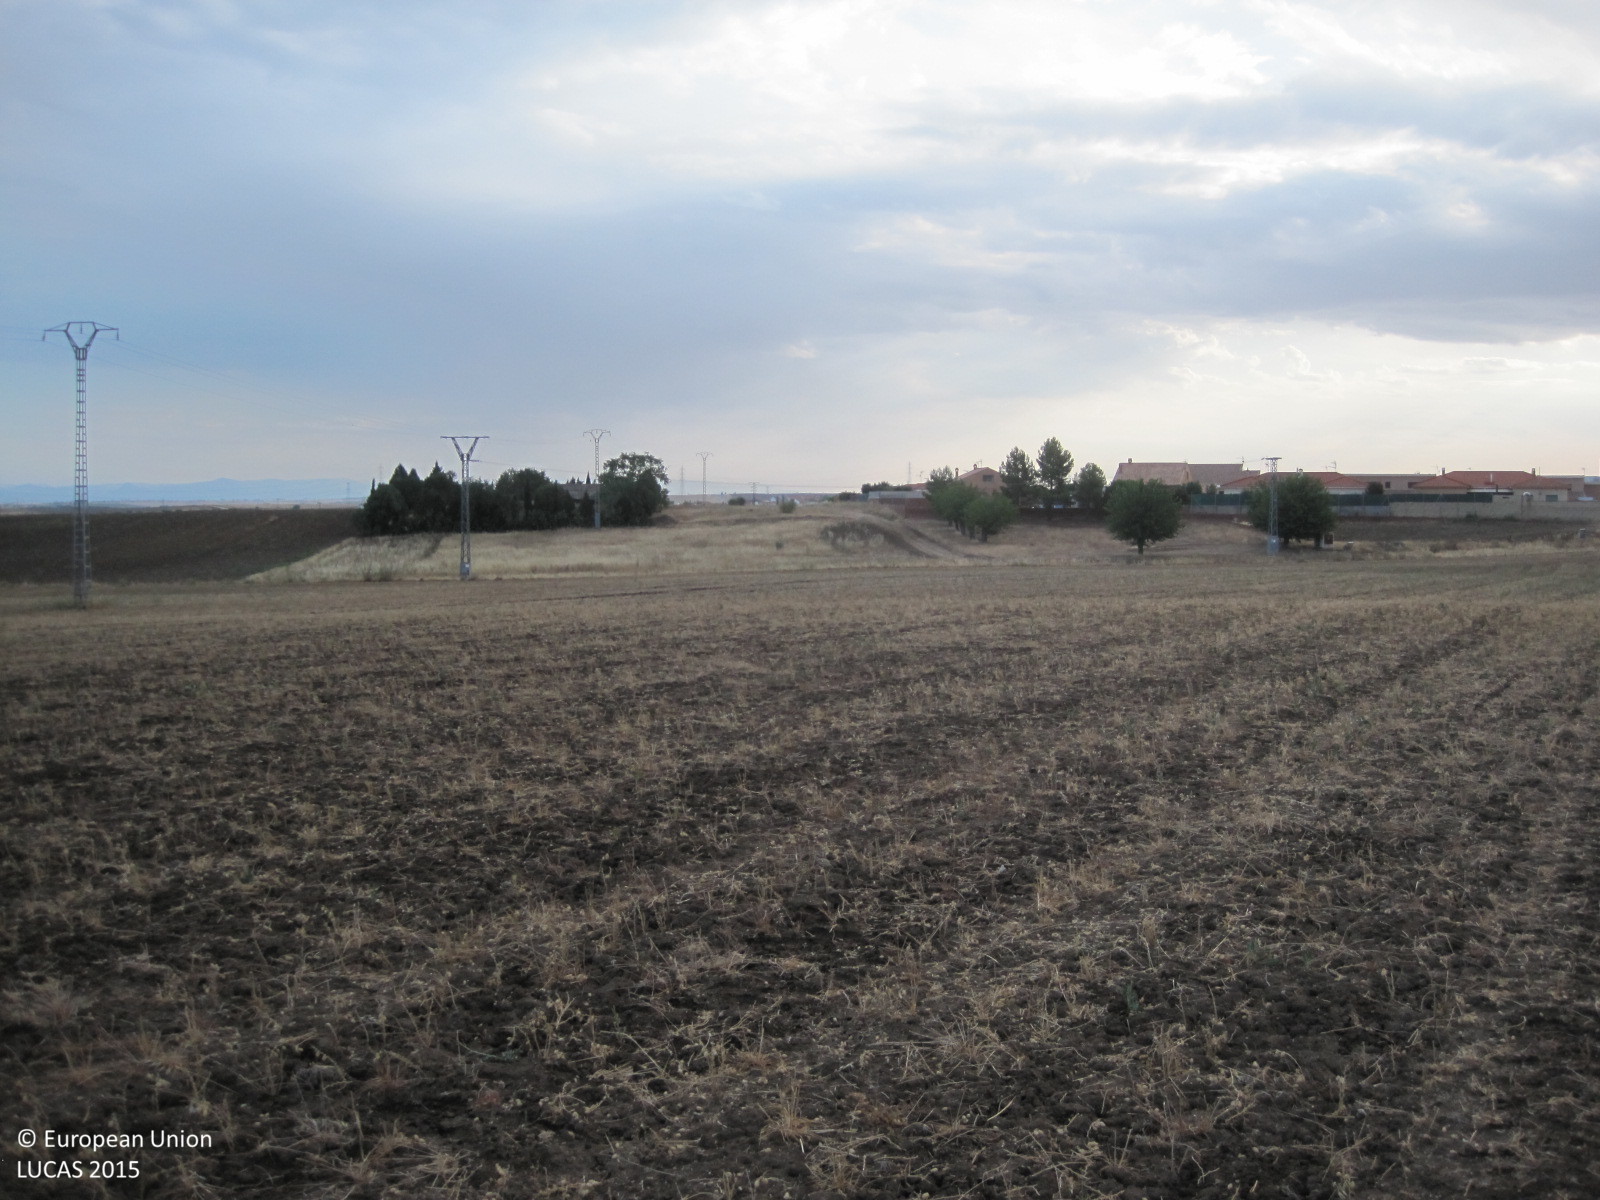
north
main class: Cropland
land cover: Dry pulses
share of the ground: < 10 %
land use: Agriculture (excluding fallow land and kitchen gardens)
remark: Harvested field
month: July
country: ES
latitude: 40.0420
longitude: -4.2809
